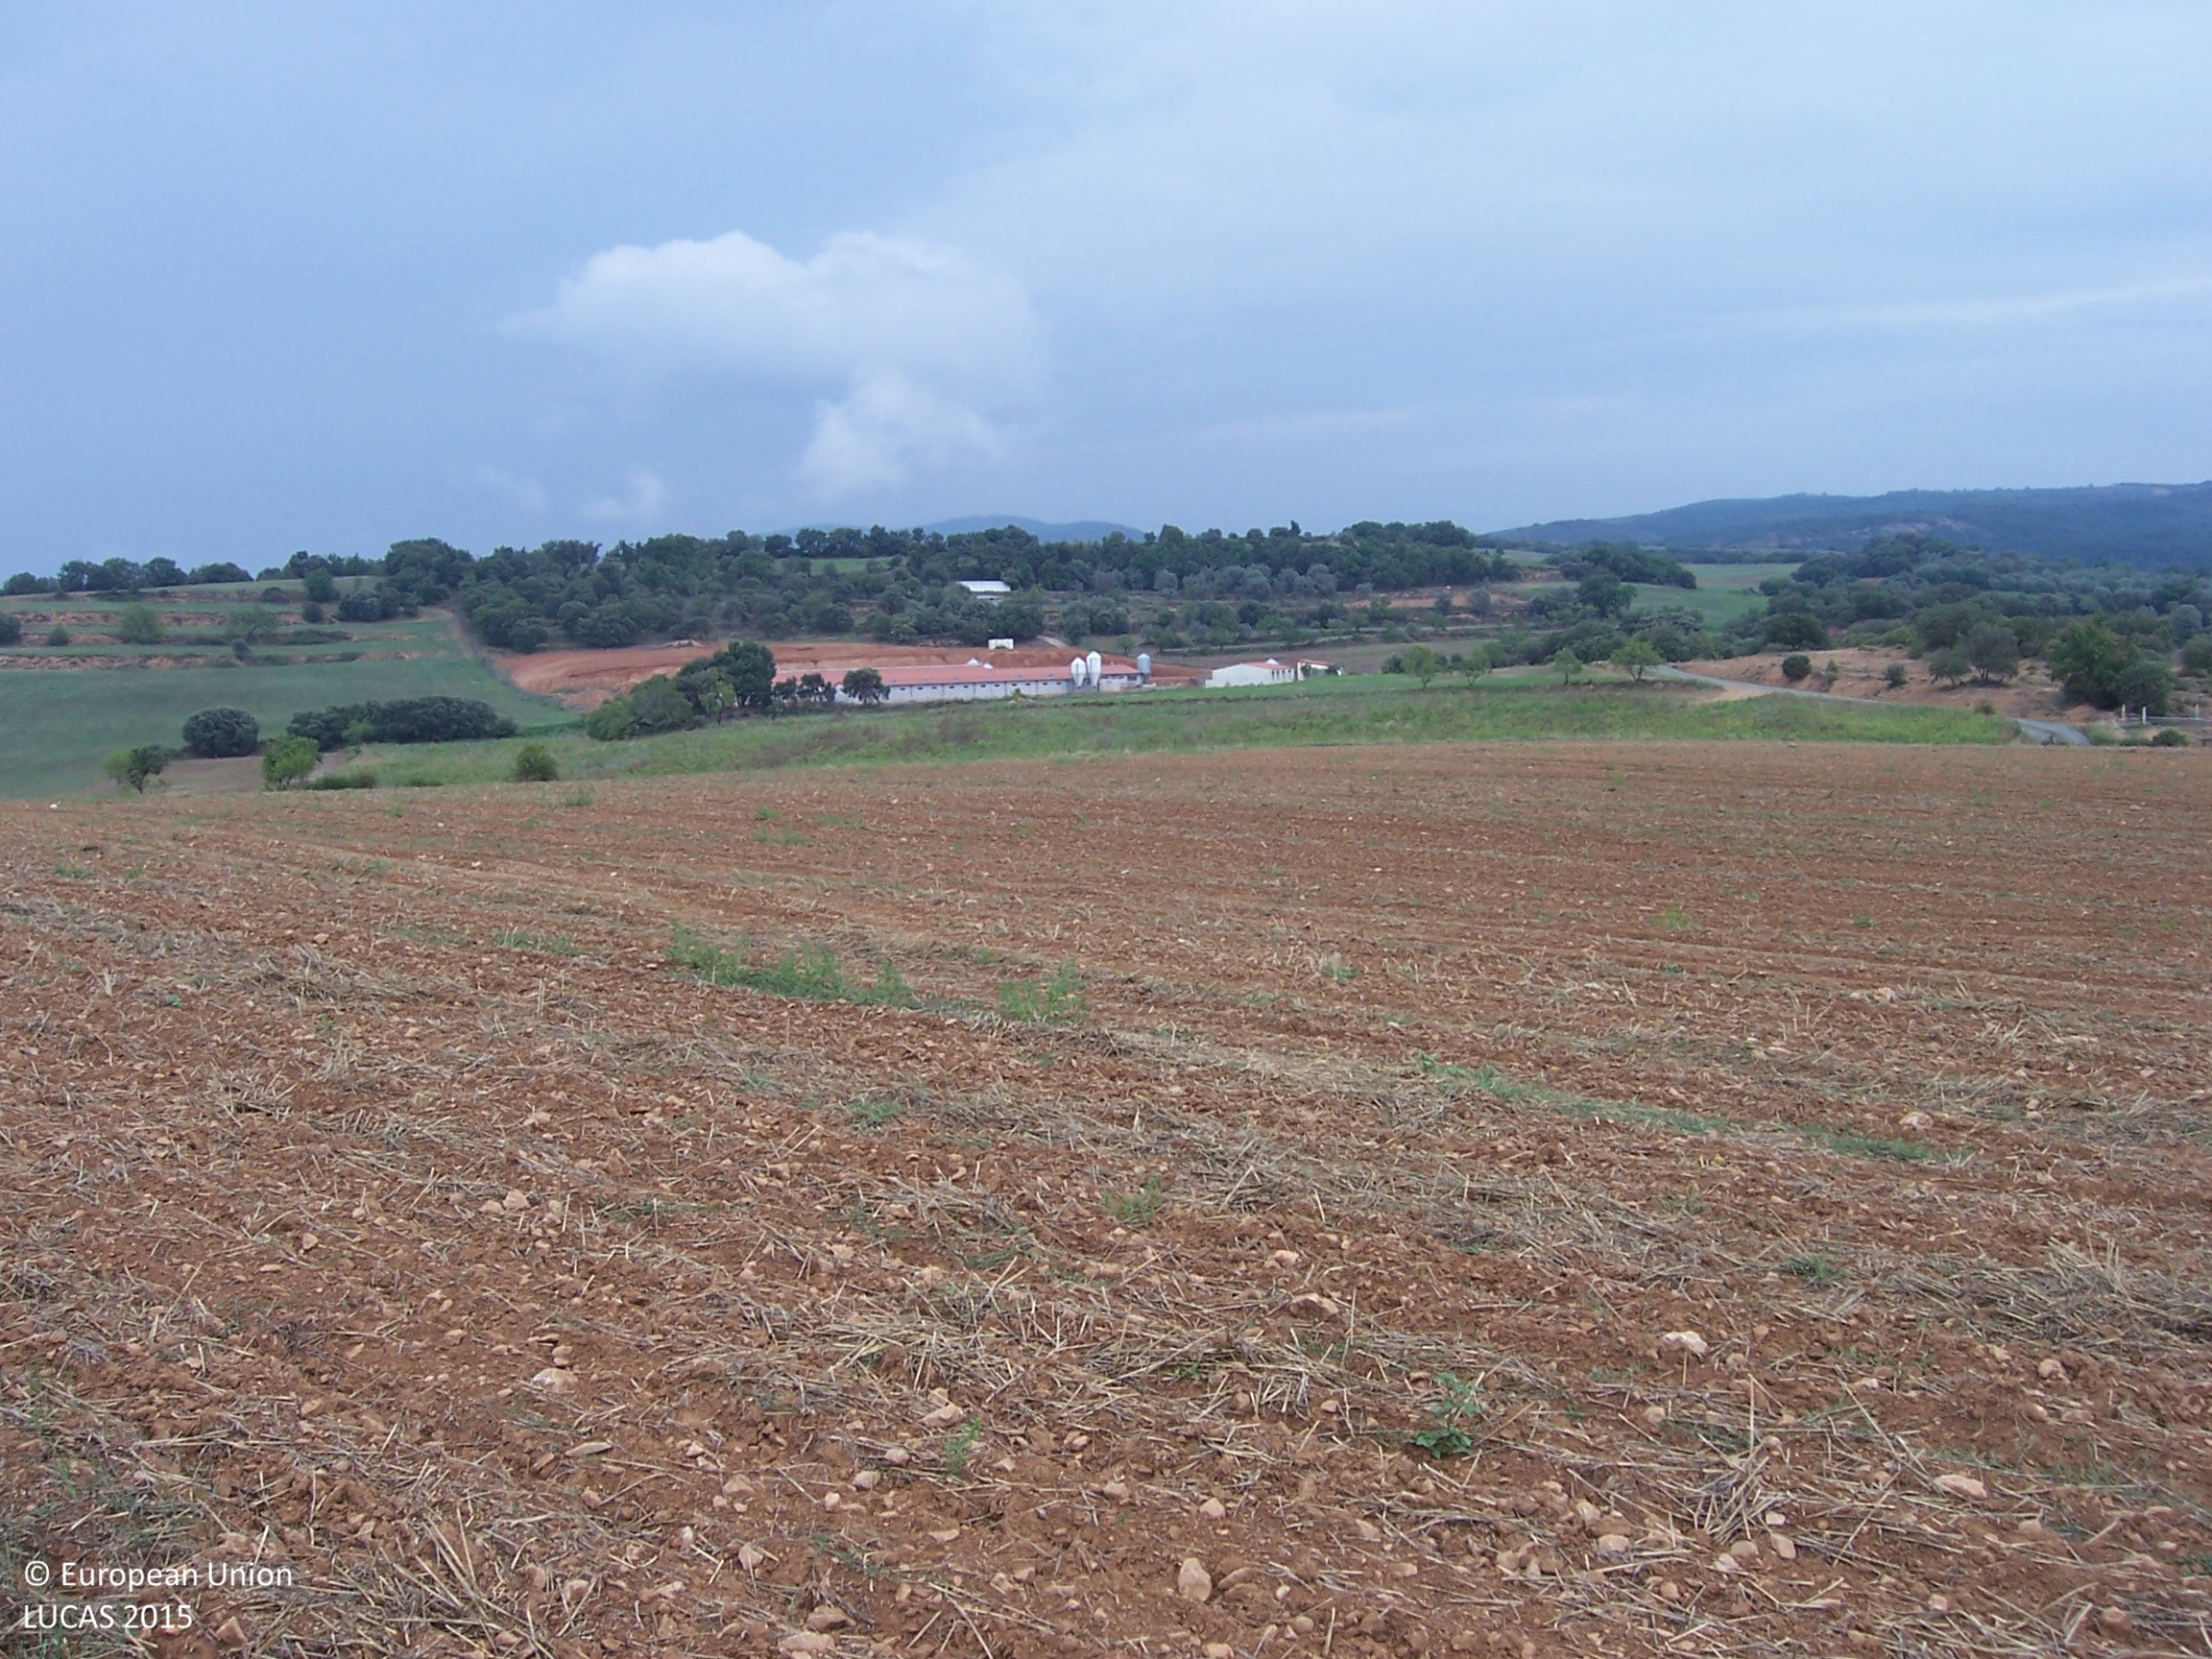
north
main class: Grassland
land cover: Spontaneously vegetated surfaces
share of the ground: > 75 %
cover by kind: unconsolidated bare surface 80 %, herbaceous plants 20 %
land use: Fallow land
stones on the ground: 10 - 25 %
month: August
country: ES
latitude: 42.1147
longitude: 0.4889
